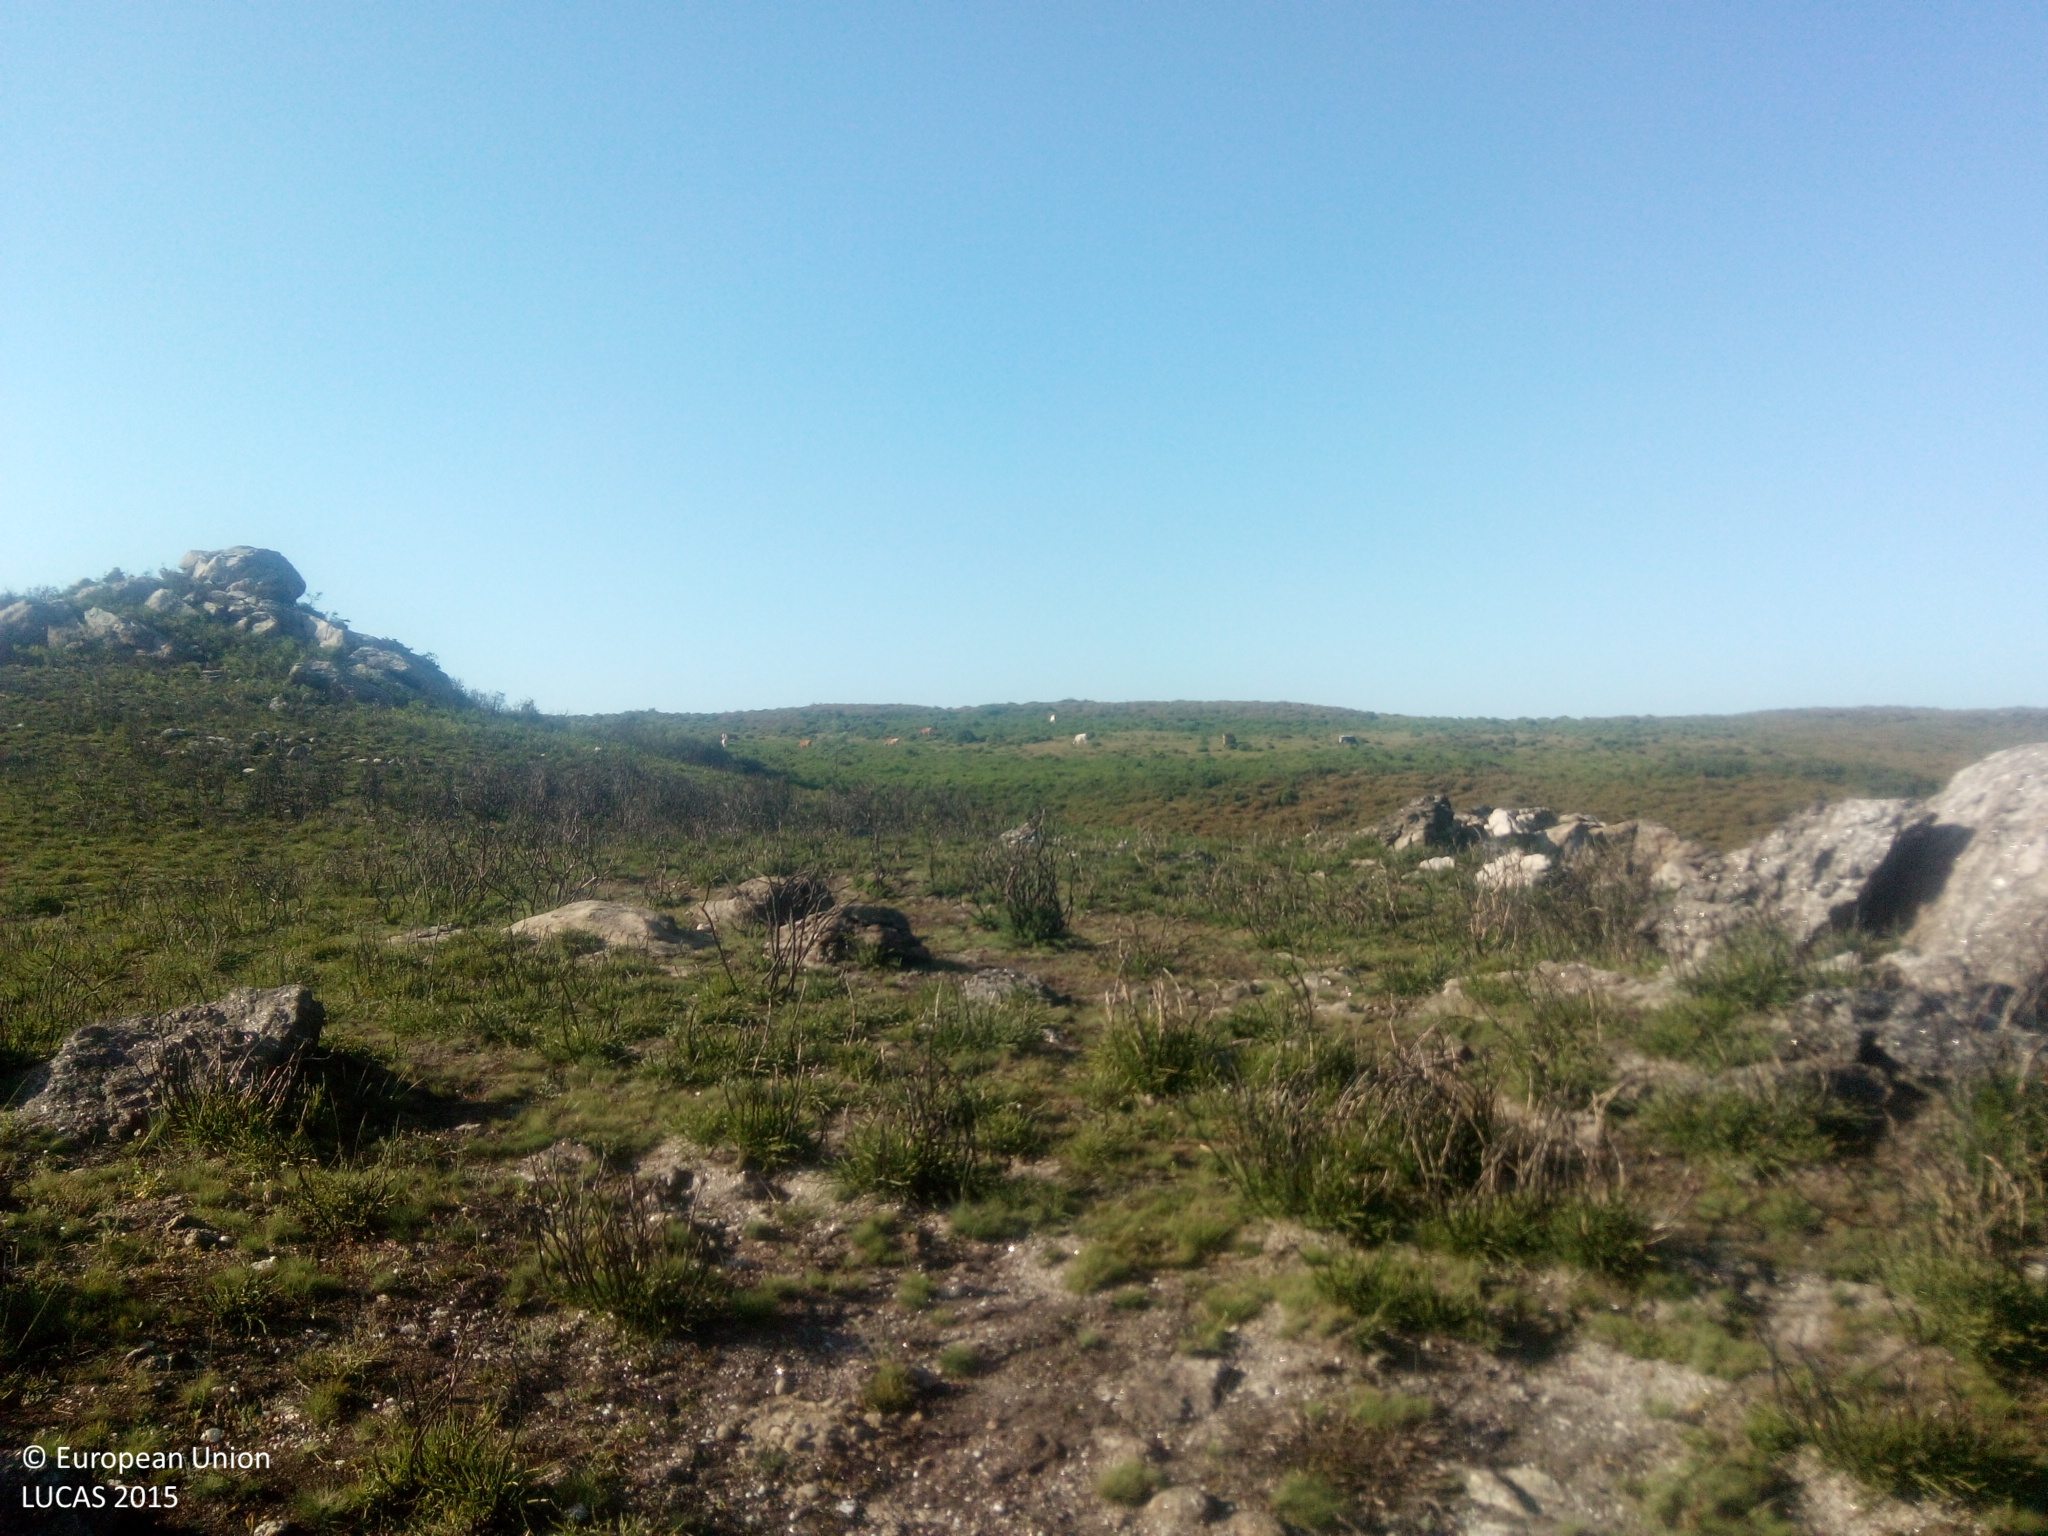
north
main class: Shrubland
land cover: Shrubland without tree cover
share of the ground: > 75 %
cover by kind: shrubs 100 %
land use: Semi-natural and natural areas not in use
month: June
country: ES
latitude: 42.2043
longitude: -8.2165
